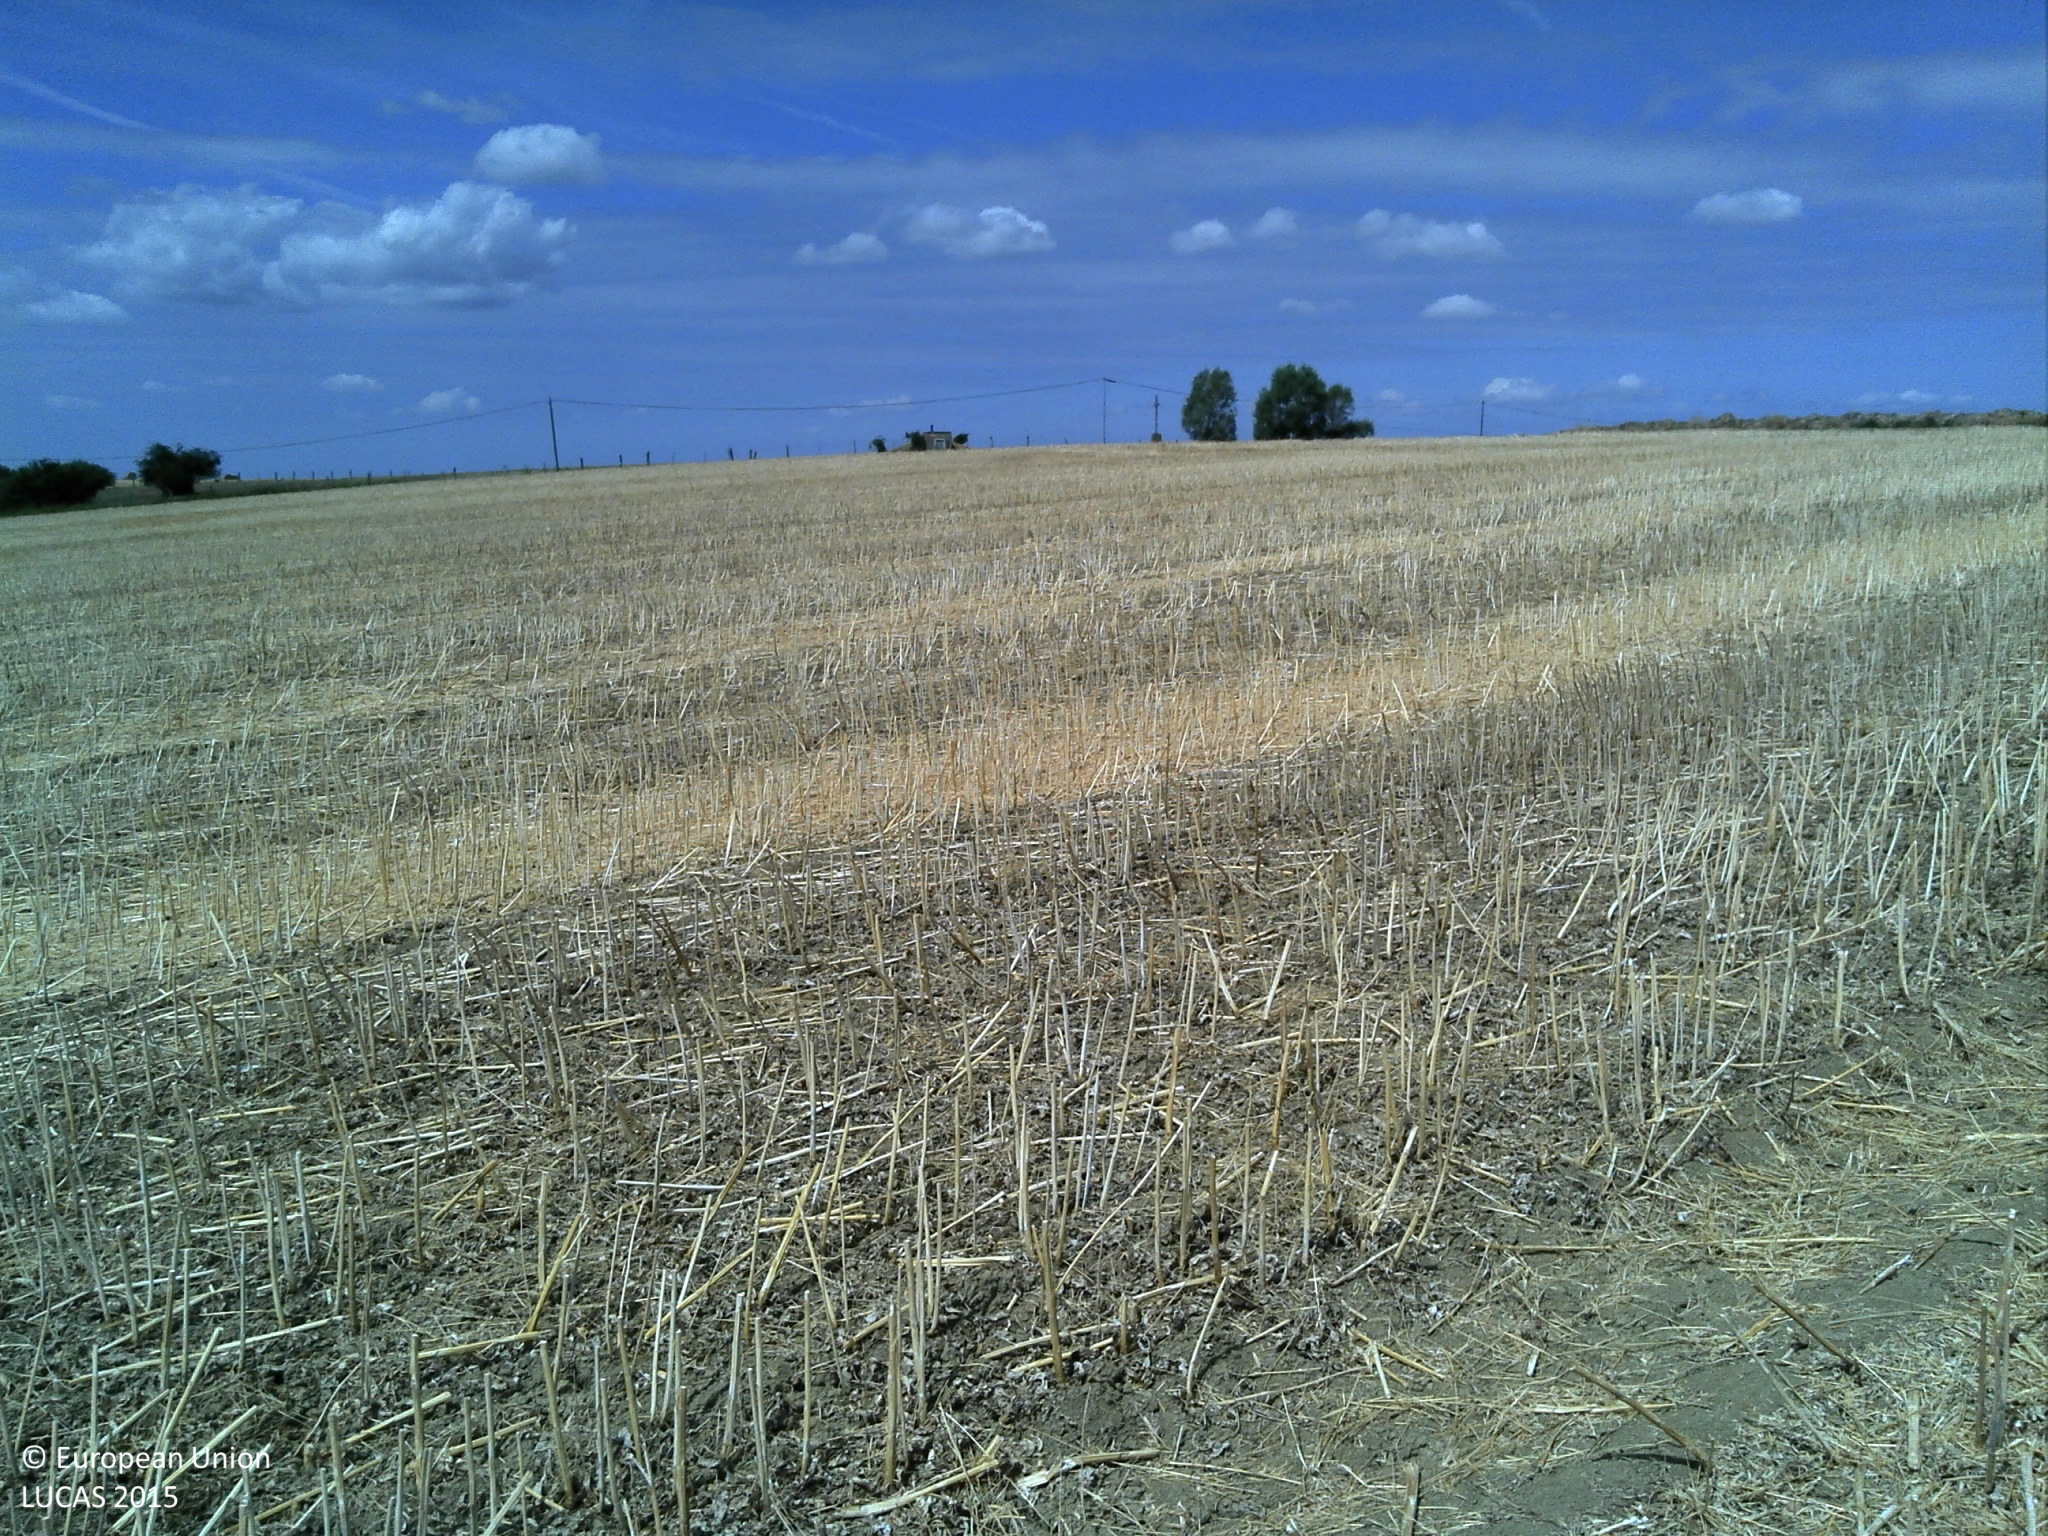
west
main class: Cropland
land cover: Rape and turnip rape
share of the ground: < 10 %
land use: Agriculture (excluding fallow land and kitchen gardens)
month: July
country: FR
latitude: 48.3499
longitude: 6.0195
